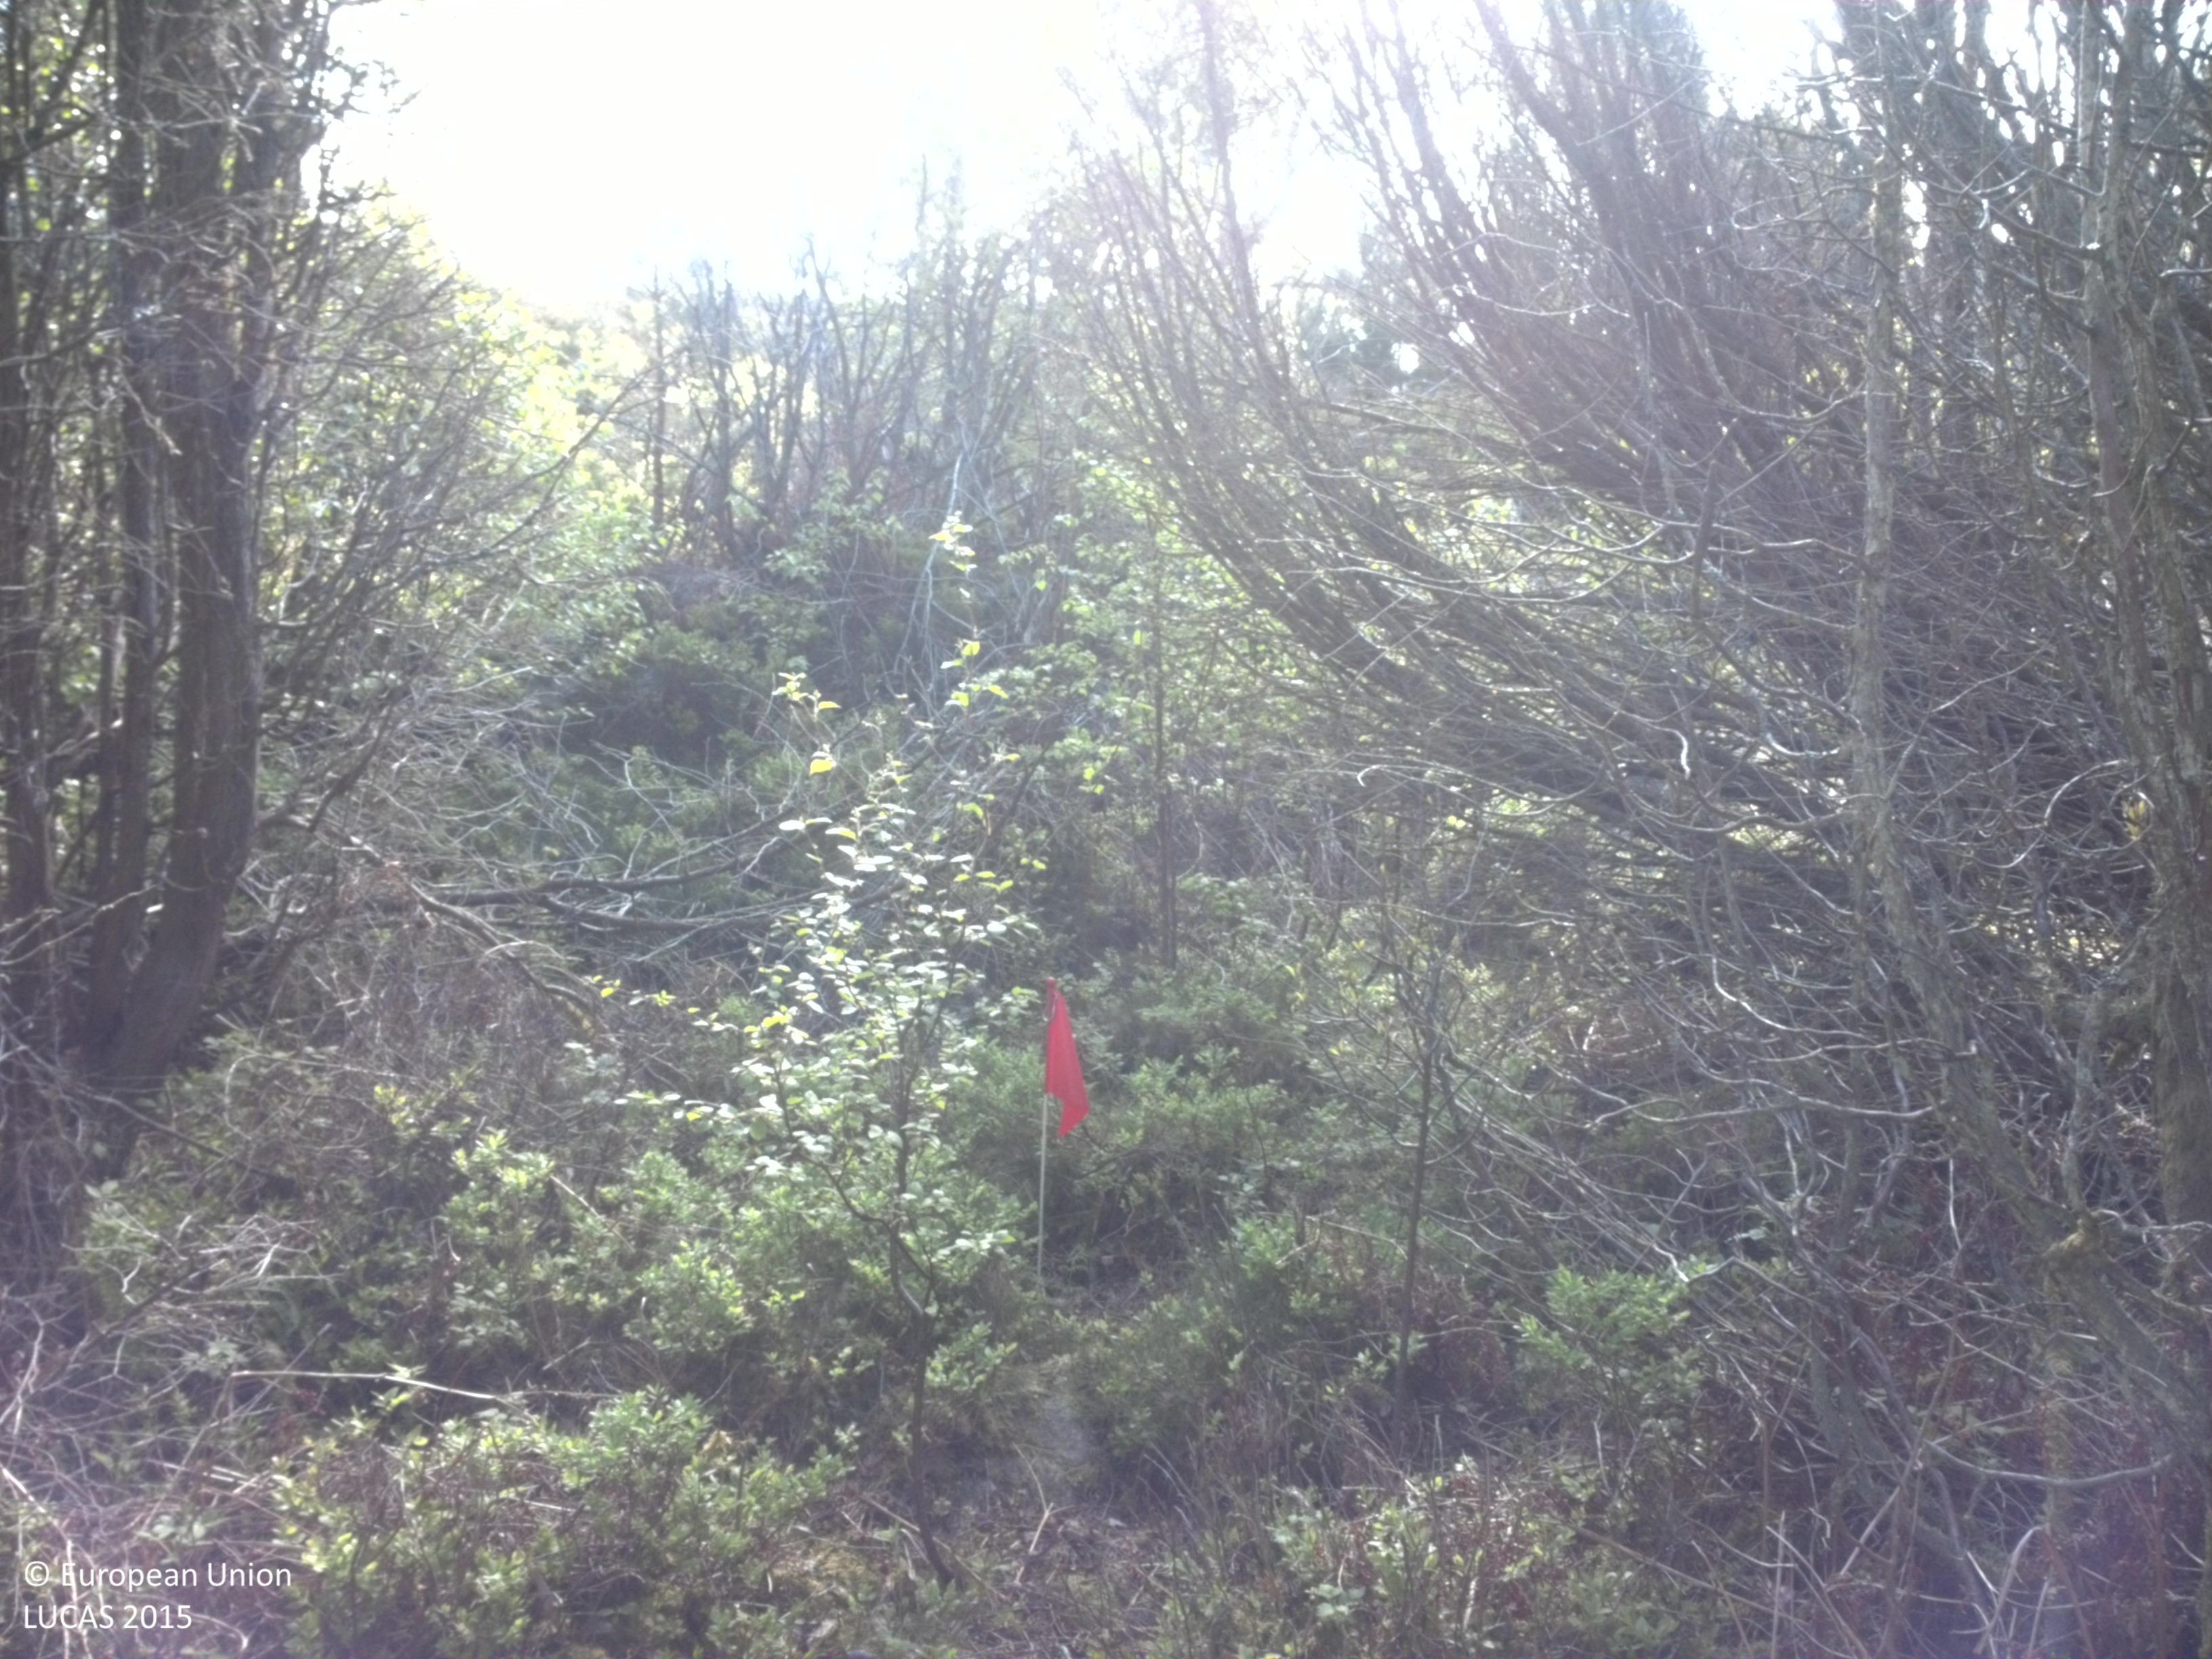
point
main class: Woodland
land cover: Pine dominated mixed woodland
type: boreal forest
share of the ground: 50 - 75 %
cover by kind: coniferous forest trees 50 %, broadleaved forest trees 25 %, shrubs 15 %, herbaceous plants 10 %
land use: Amenities, museums, leisure
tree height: > 5 m
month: May
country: SE
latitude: 57.6116
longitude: 11.9552
